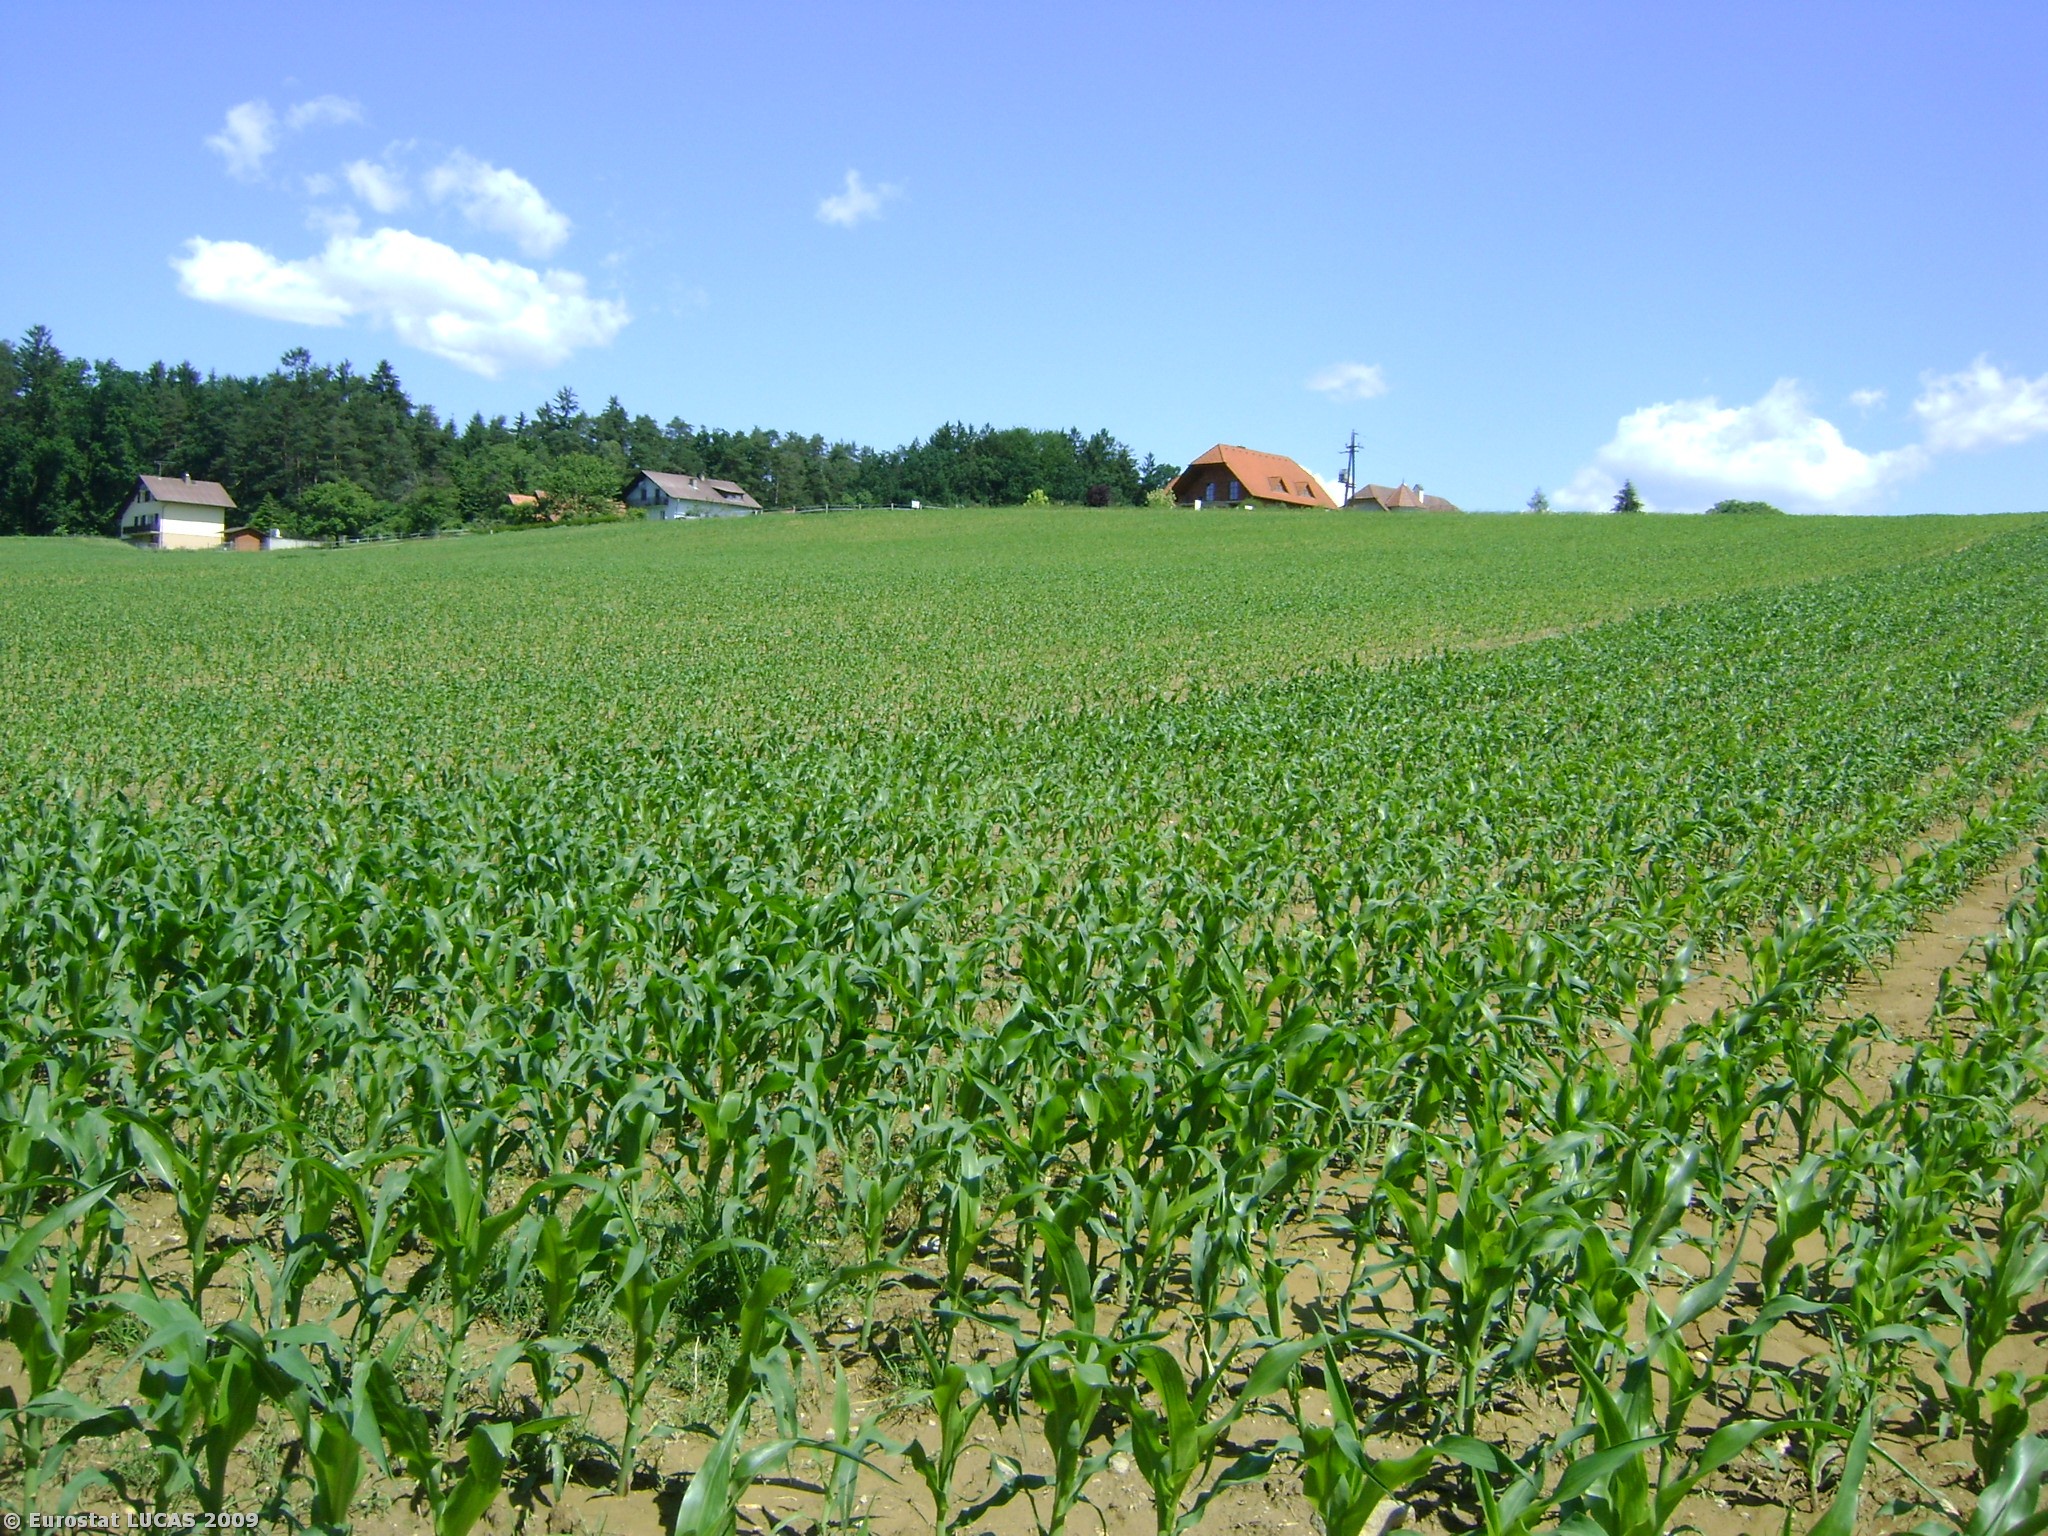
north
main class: Cropland
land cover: Maize
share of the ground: 25 - 50 %
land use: Agriculture (excluding fallow land and kitchen gardens)
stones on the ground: < 10 %
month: May
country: AT
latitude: 46.8130
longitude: 15.7007
